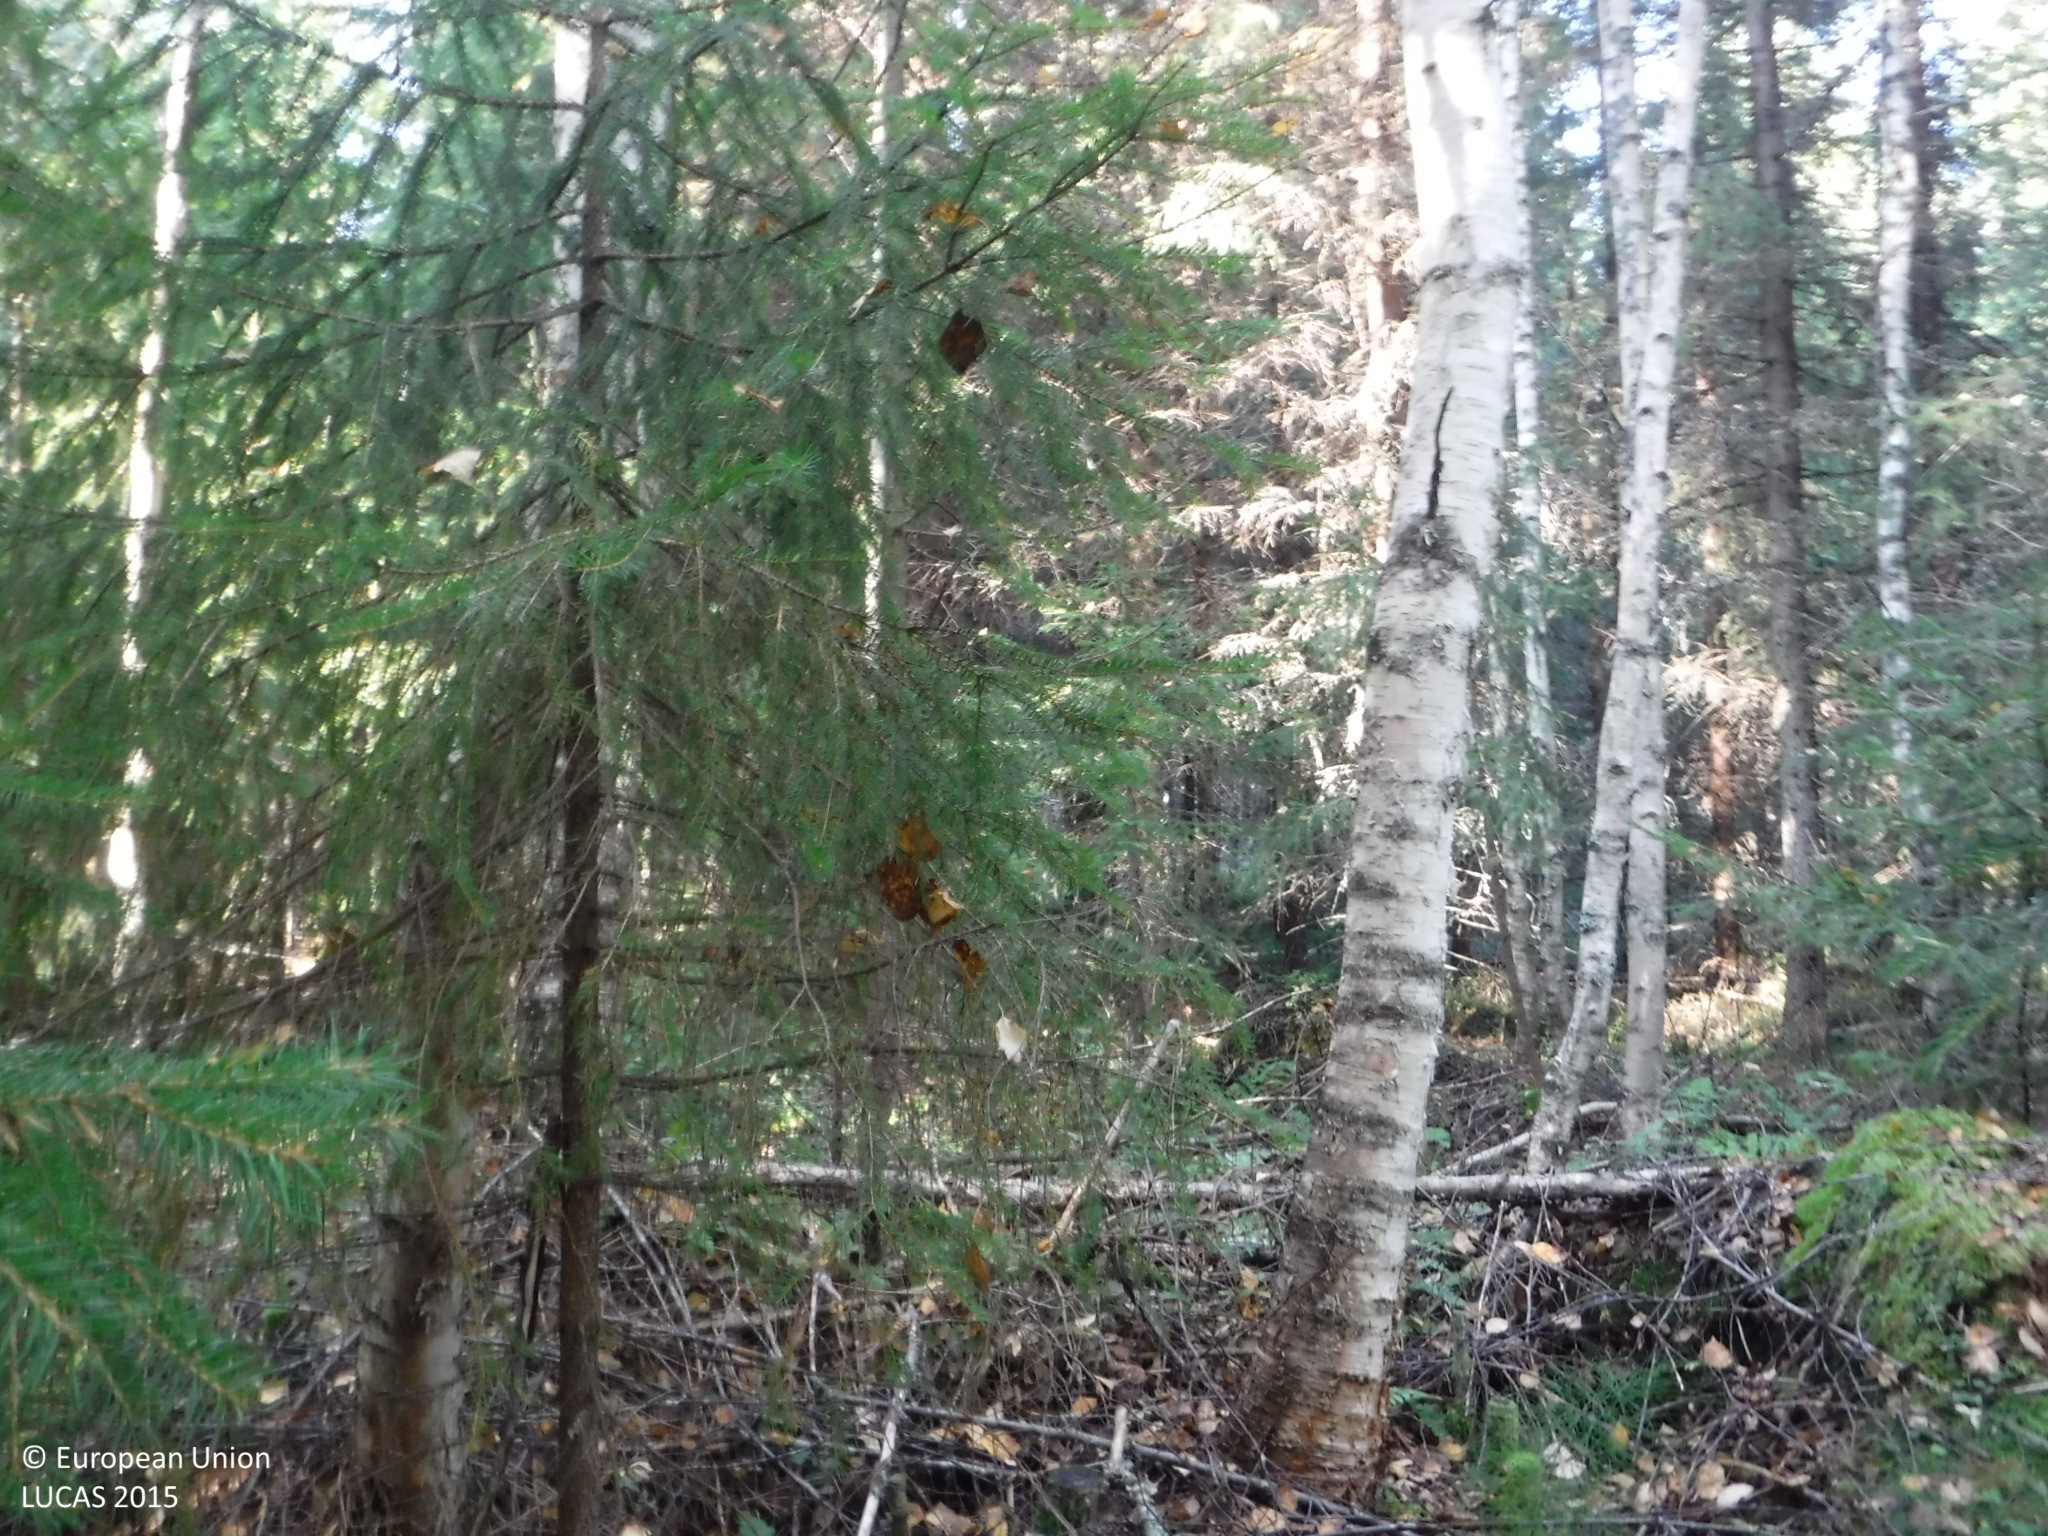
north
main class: Woodland
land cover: Spruce dominated mixed woodland
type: boreal forest
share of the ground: 50 - 75 %
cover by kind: coniferous forest trees 30 %, broadleaved forest trees 30 %, herbaceous plants 30 %, shrubs 5 %, lichens and mosses 5 %
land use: Forestry
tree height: > 5 m
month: September
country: FI
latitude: 61.6836
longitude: 22.7464
